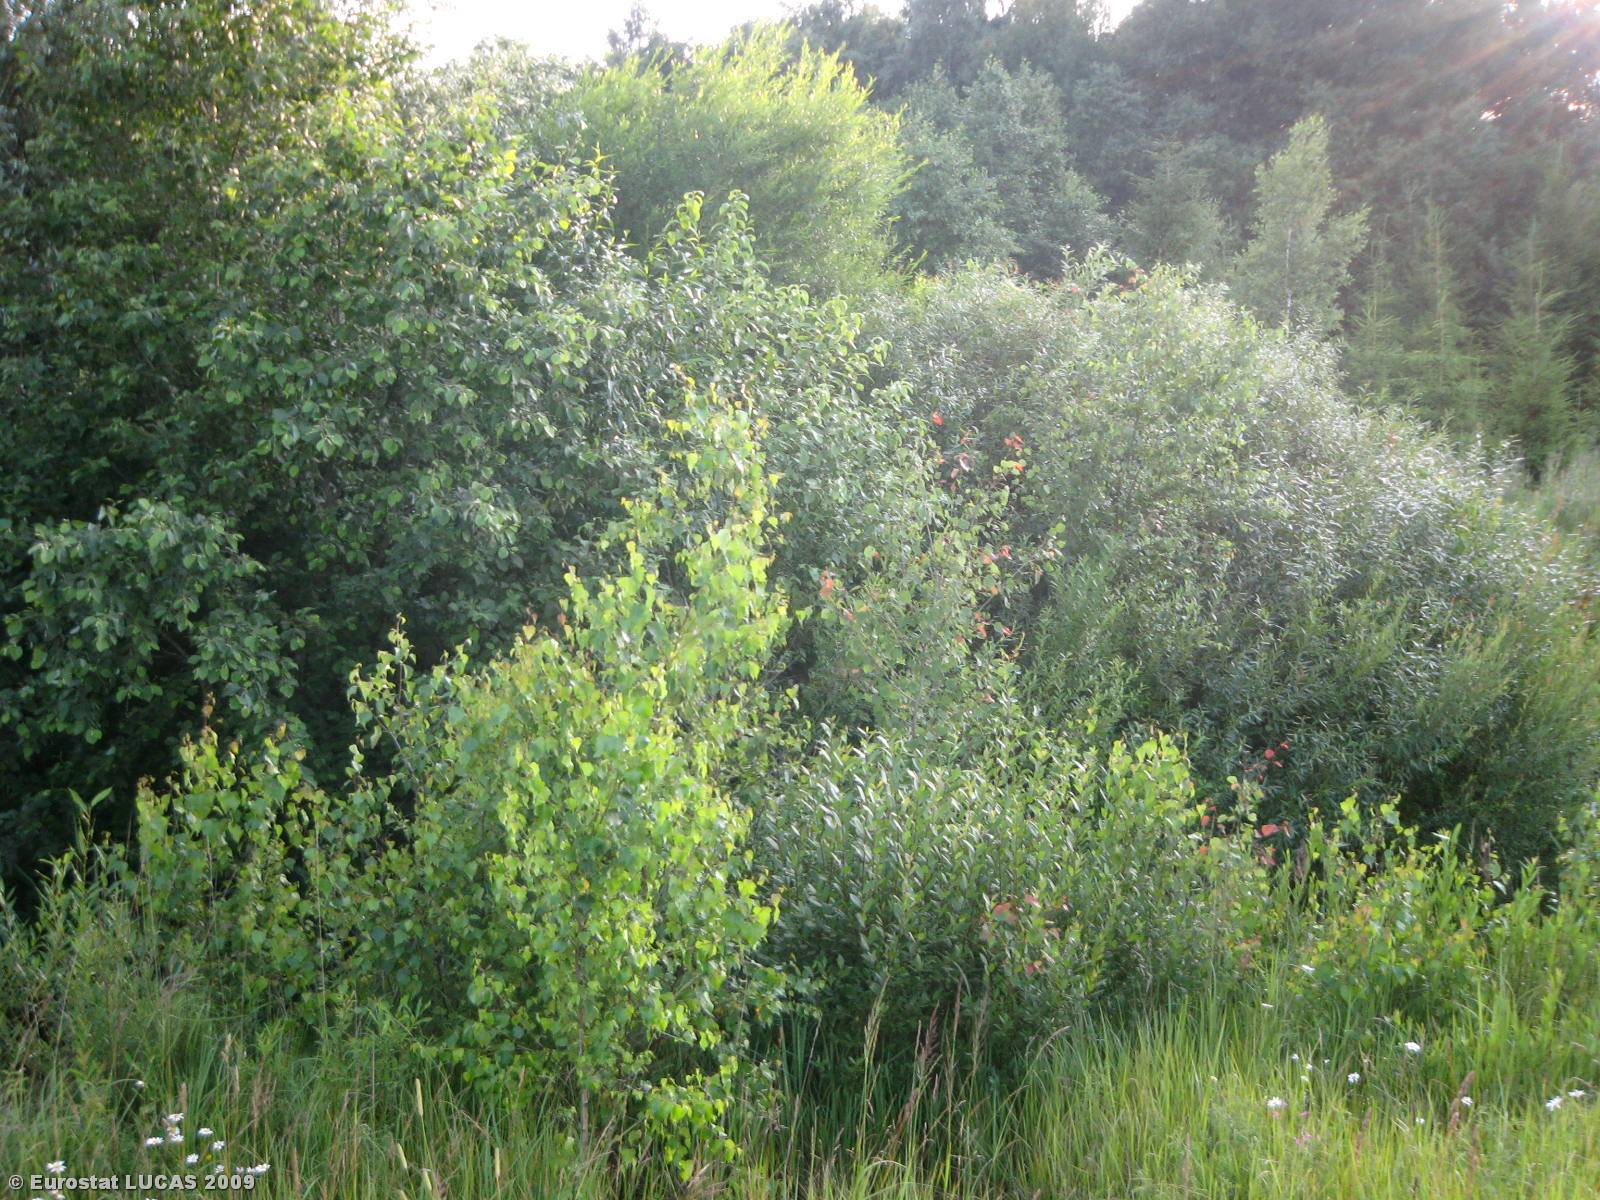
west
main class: Grassland
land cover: Grassland without tree/shrub cover
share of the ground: > 75 %
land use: Road transport
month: July
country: LT
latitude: 55.3462
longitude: 24.7561
